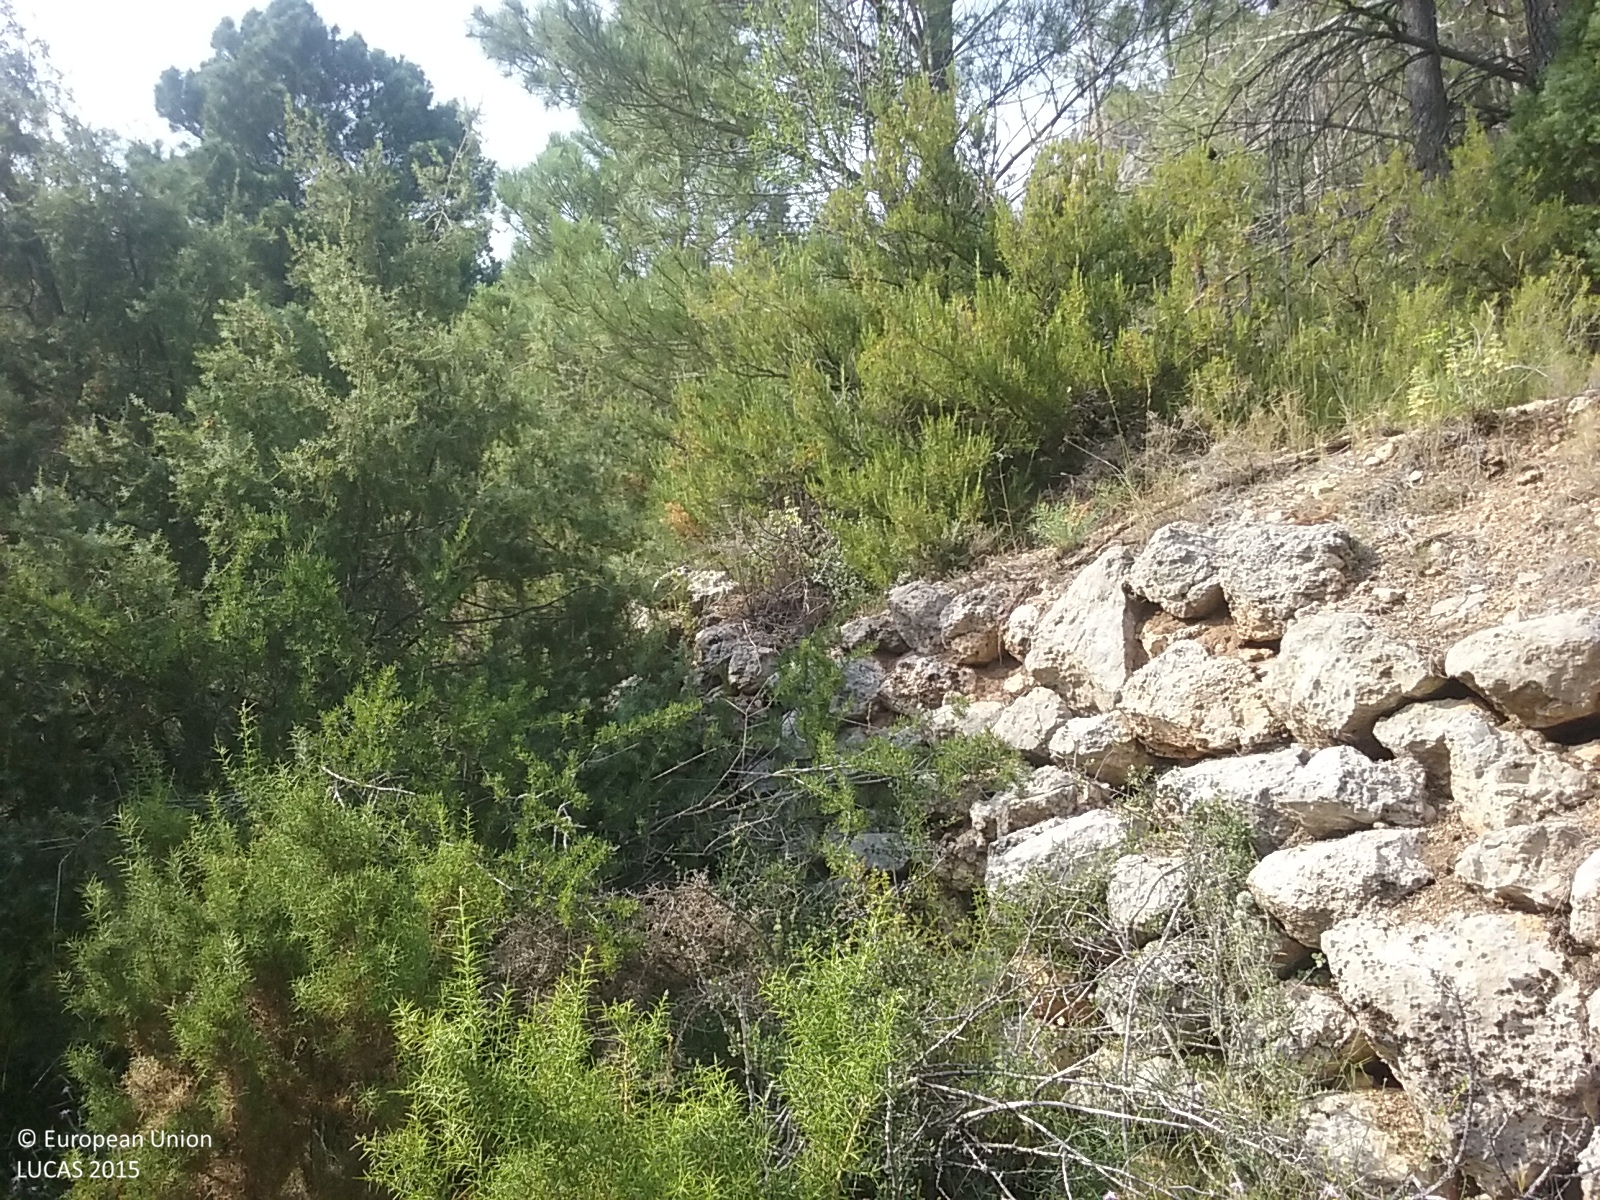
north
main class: Woodland
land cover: Pine dominated coniferous woodland
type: coniferous forest of the mediterranean region
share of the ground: 25 - 50 %
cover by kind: shrubs 80 %, coniferous forest trees 20 %
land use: Forestry
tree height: > 5 m
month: July
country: ES
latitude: 39.9320
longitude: -0.7344
